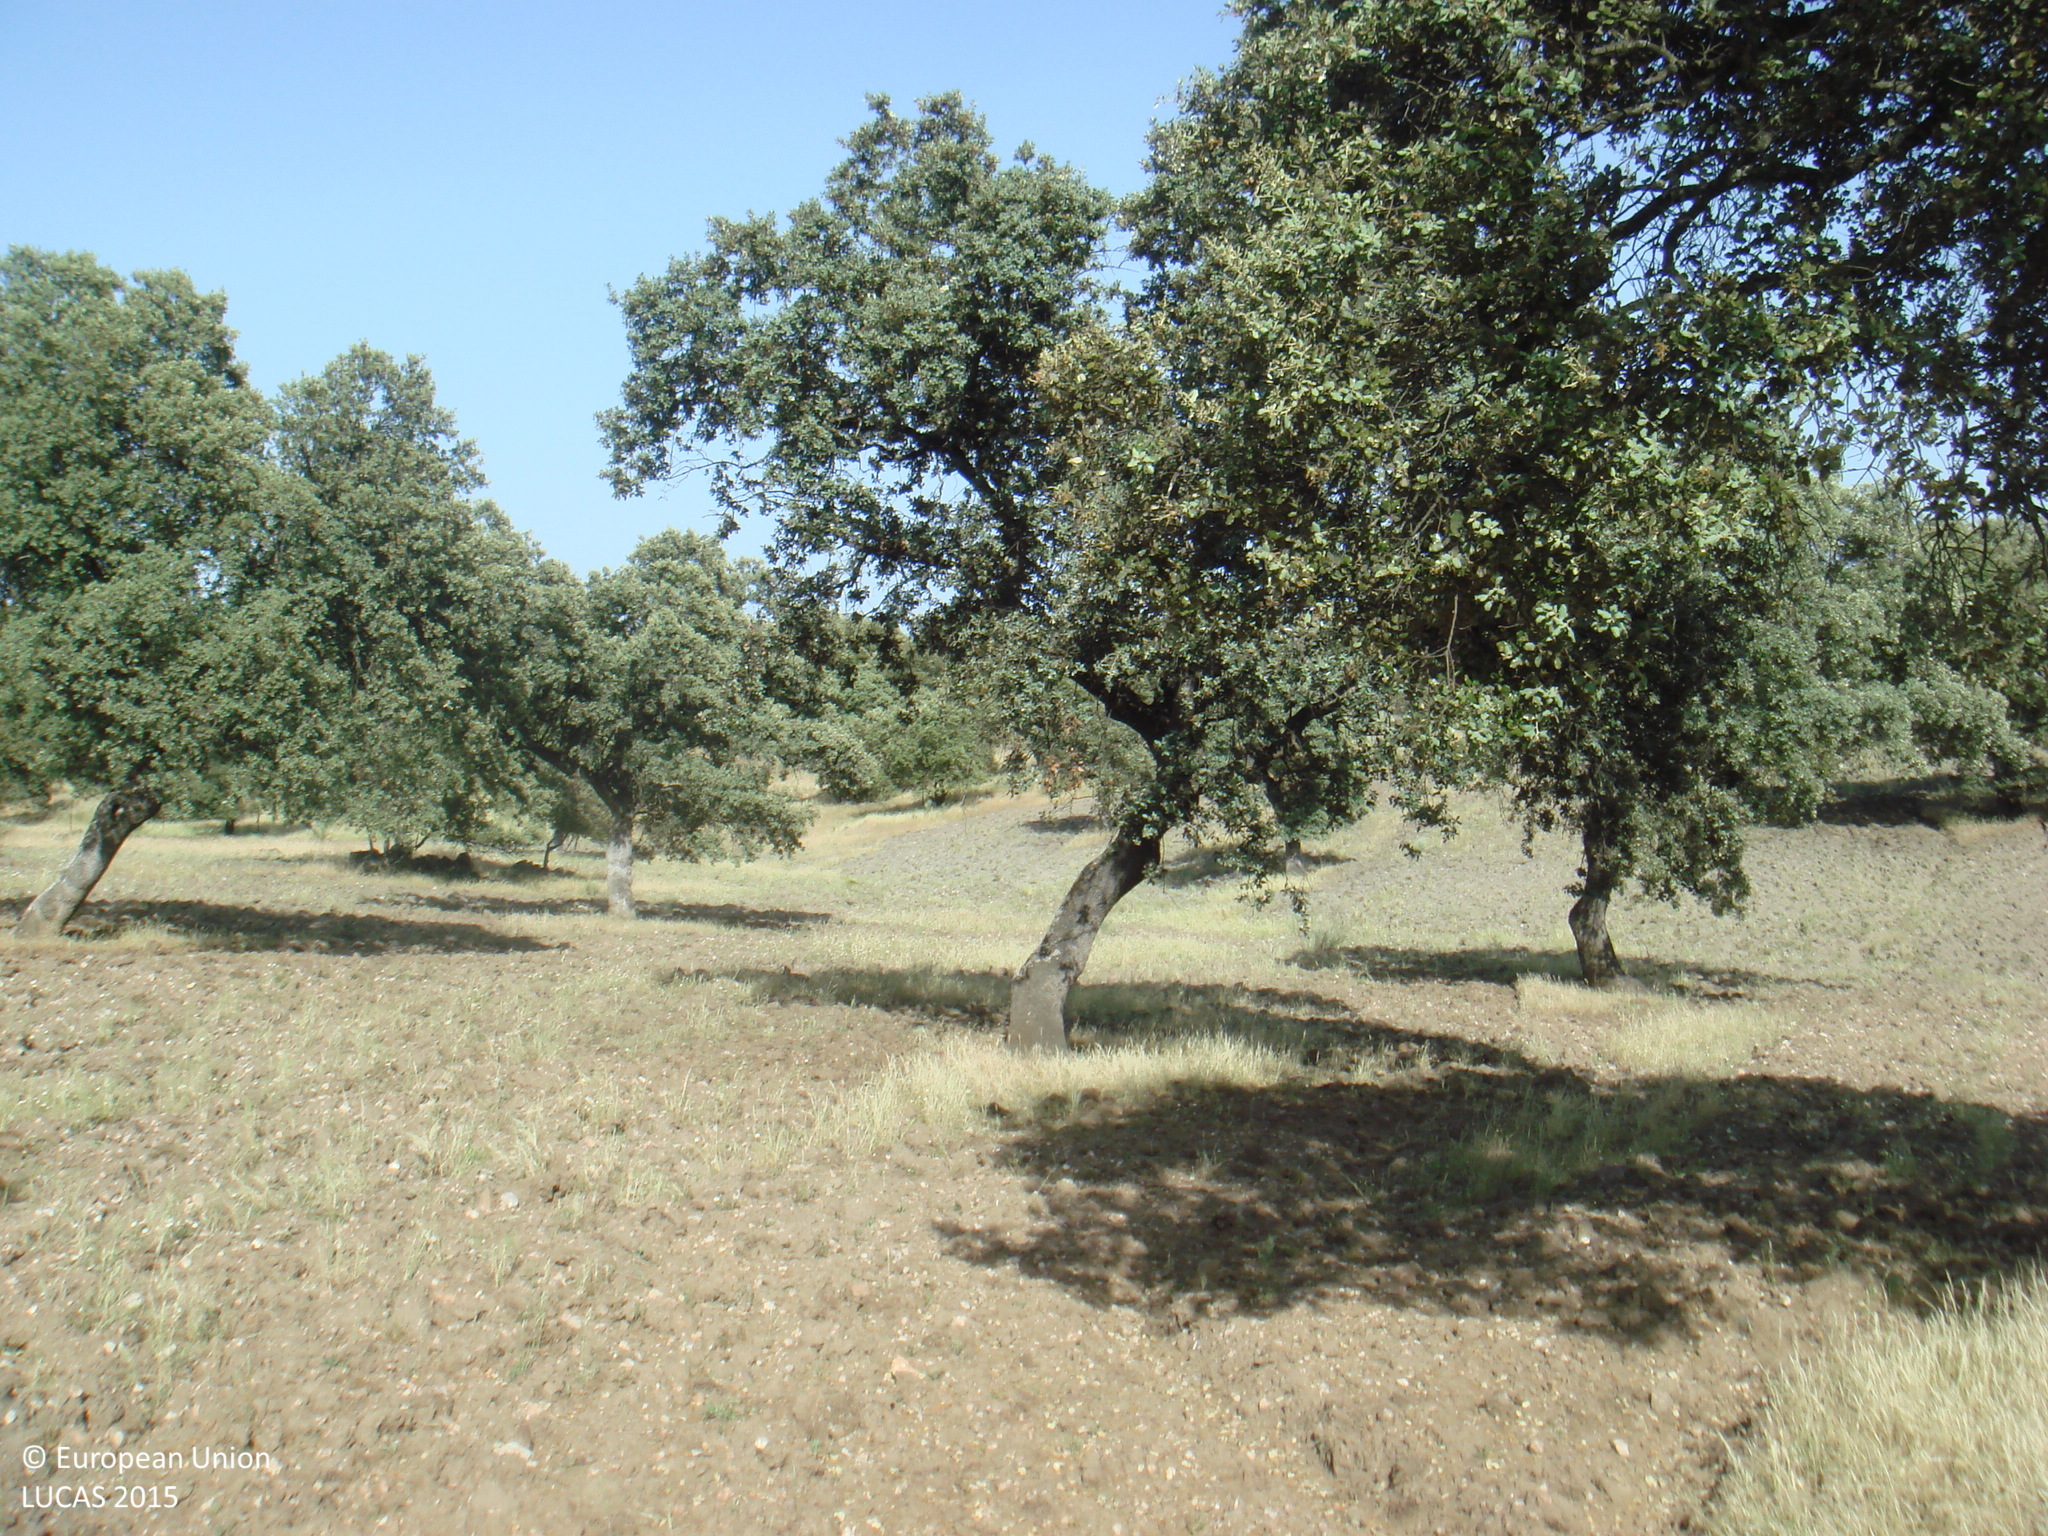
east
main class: Woodland
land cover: Broadleaved woodland
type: broadleaved evergreen forest
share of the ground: 25 - 50 %
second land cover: Spontaneously vegetated surfaces
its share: 10 - 25 %
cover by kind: unconsolidated bare surface 45 %, broadleaved forest trees 40 %, herbaceous plants 15 %
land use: Forestry
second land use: Agriculture (excluding fallow land and kitchen gardens)
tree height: > 5 m
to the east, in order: Broadleaved woodland; Spontaneously vegetated surfaces; Fences; Broadleaved woodland; Fences; Broadleaved woodland
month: May
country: ES
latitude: 38.5157
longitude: -4.7852
